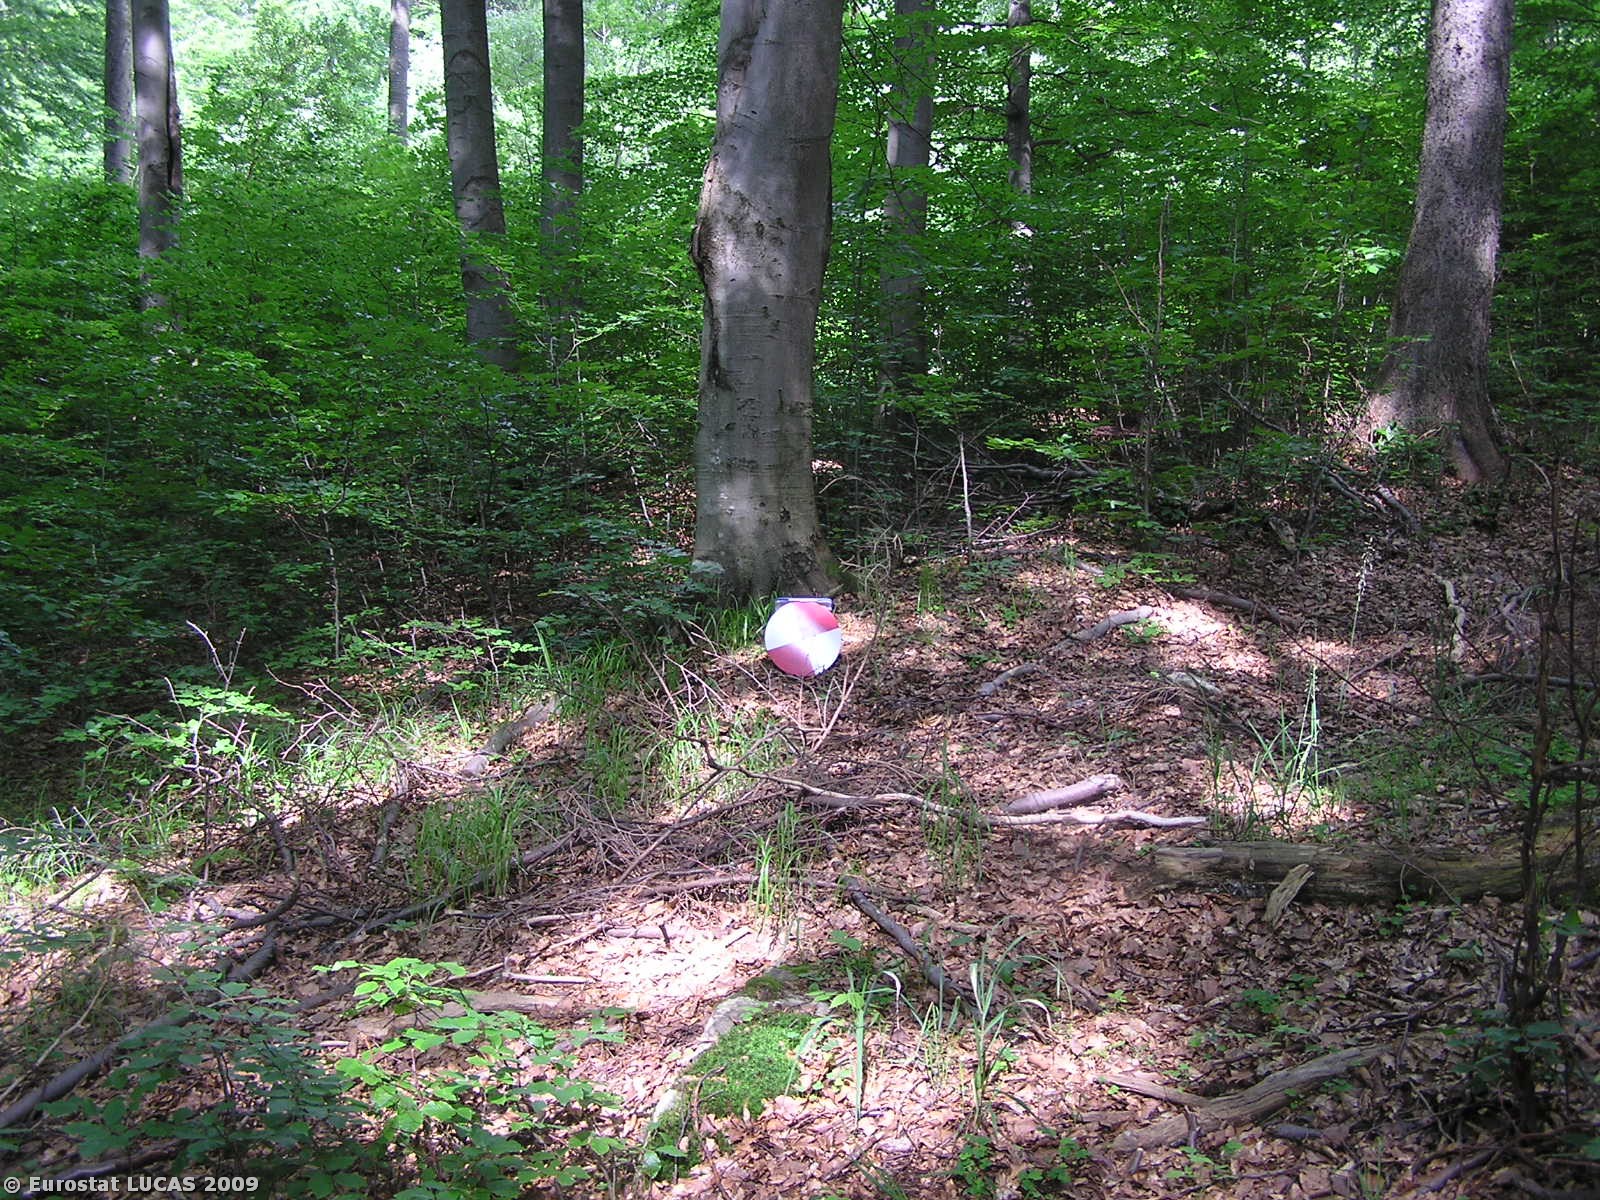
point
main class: Woodland
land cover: Broadleaved woodland
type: mountainous beech forest
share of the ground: > 75 %
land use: Forestry
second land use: Nature reserves
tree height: > 5 m
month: July
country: CZ
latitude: 50.0931
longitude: 17.3221
